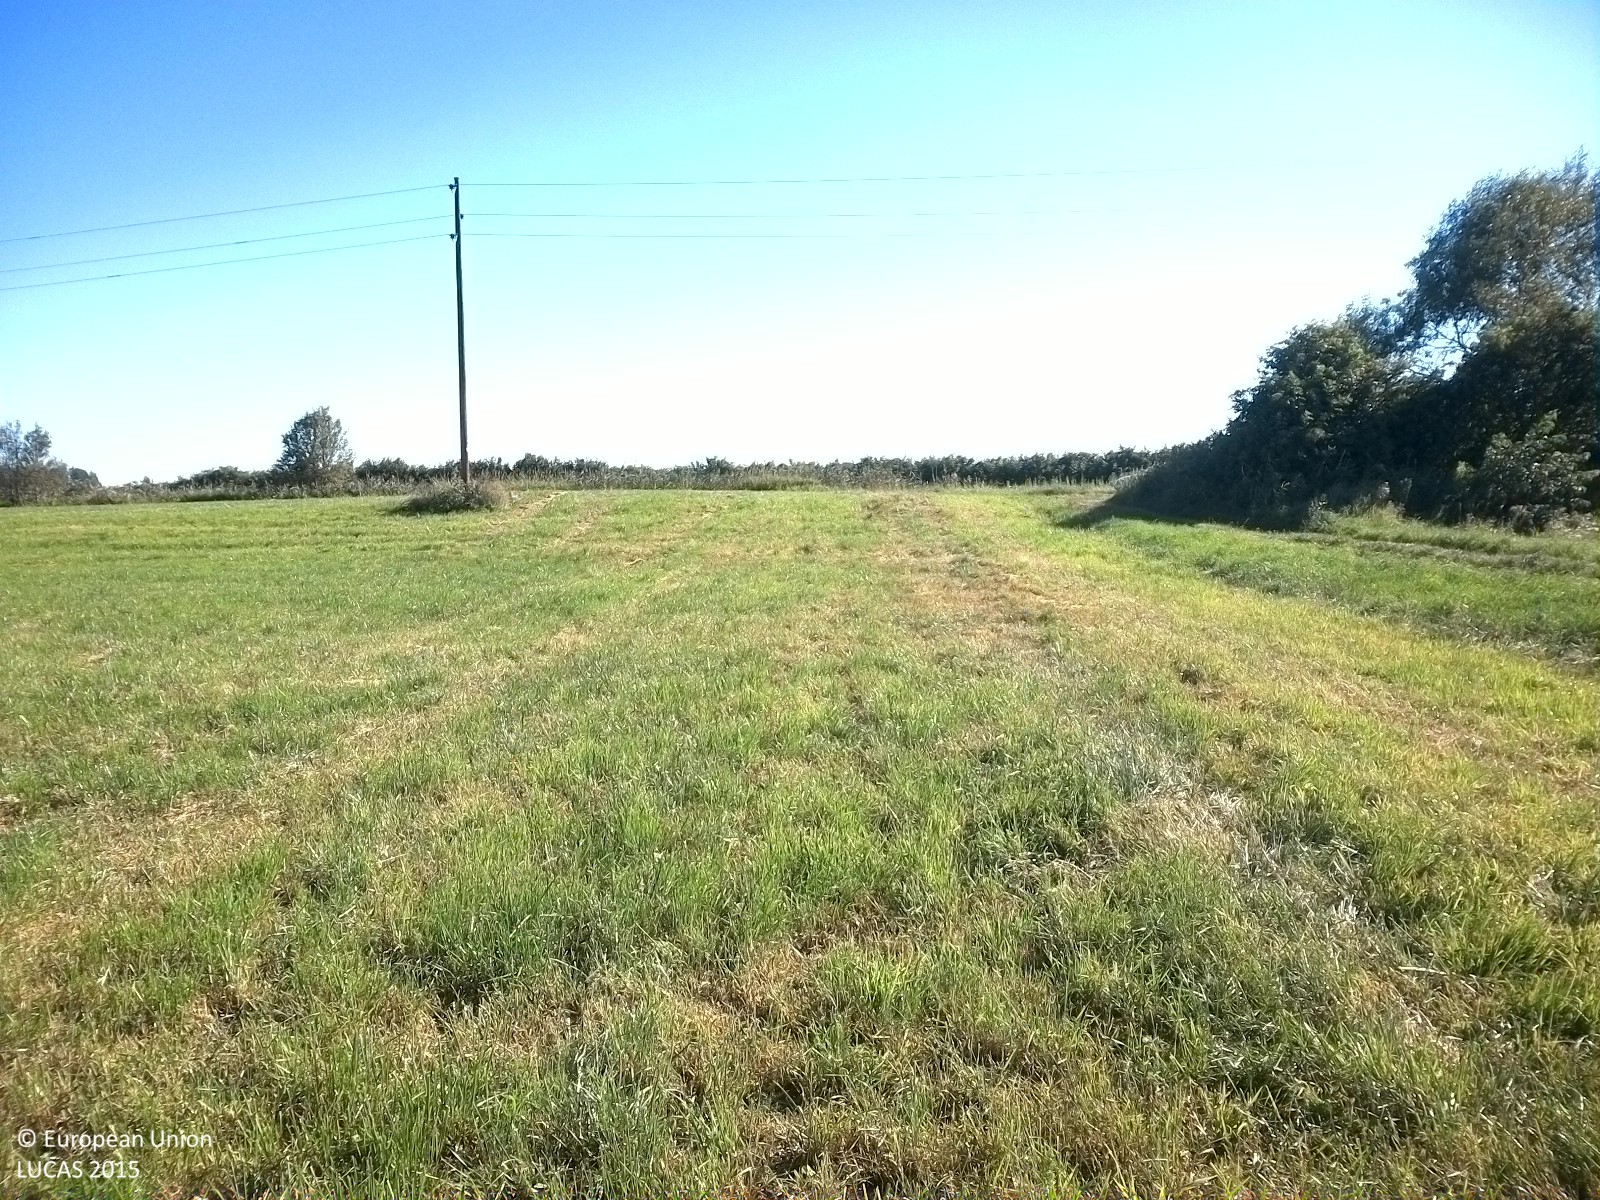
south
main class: Cropland
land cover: Temporary grasslands
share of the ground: > 75 %
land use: Agriculture (excluding fallow land and kitchen gardens)
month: August
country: SE
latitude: 59.1711
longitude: 15.5029
